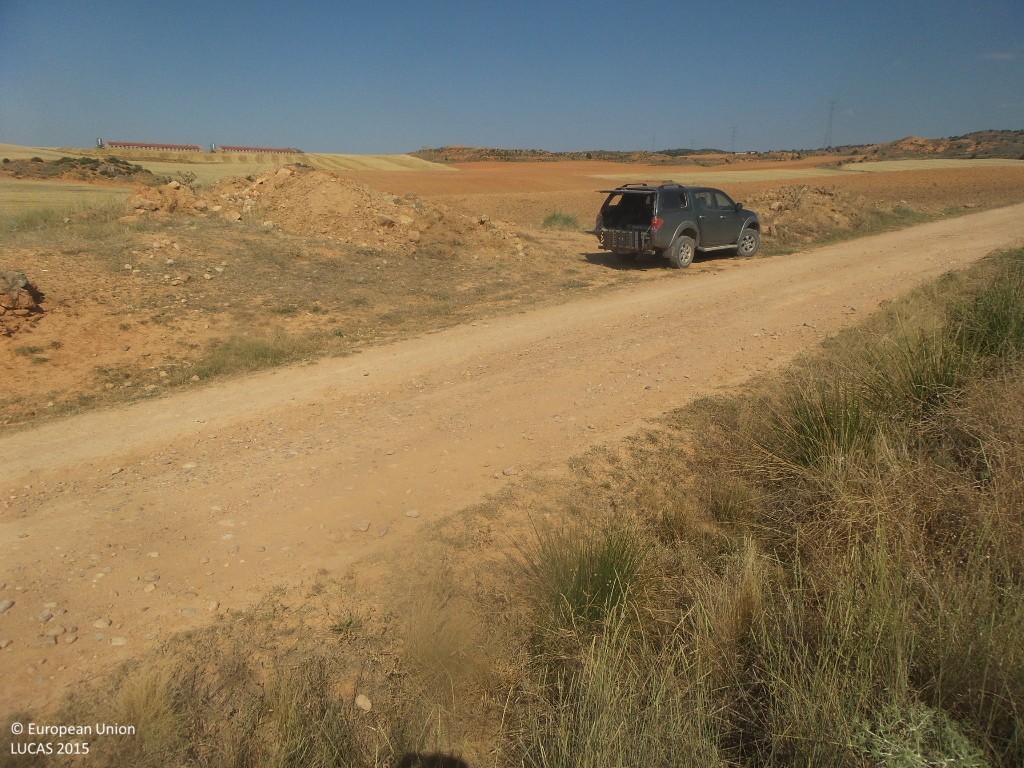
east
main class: Grassland
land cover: Spontaneously vegetated surfaces
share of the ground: > 75 %
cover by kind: herbaceous plants 90 %, unconsolidated bare surface 10 %
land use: Semi-natural and natural areas not in use
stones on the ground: < 10 %
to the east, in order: Spontaneously vegetated surfaces; Tracks; Grass margins; Spontaneously vegetated surfaces; Inland fresh water bodies; Other bare soil
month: July
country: ES
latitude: 41.1950
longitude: -2.1068
